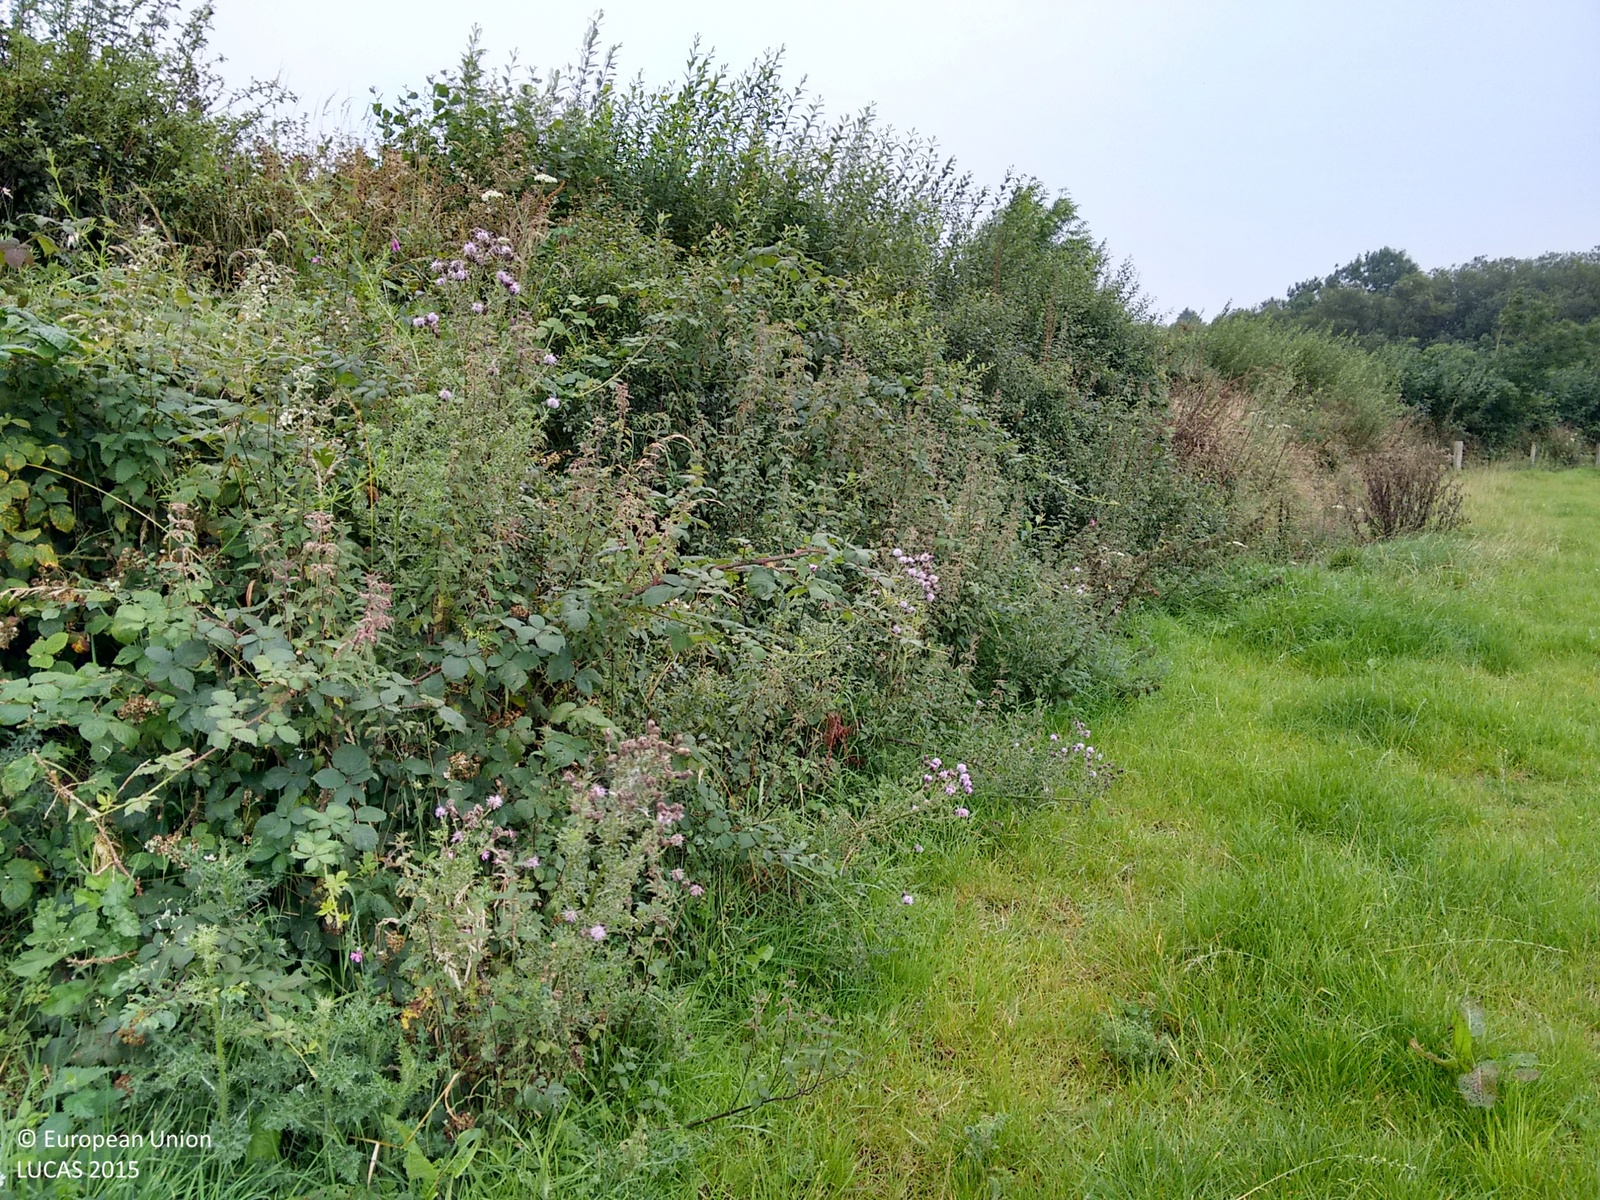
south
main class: Grassland
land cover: Grassland without tree/shrub cover
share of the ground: > 75 %
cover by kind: herbaceous plants 100 %
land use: Agriculture (excluding fallow land and kitchen gardens)
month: August
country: GB
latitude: 51.7908
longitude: -4.6506
